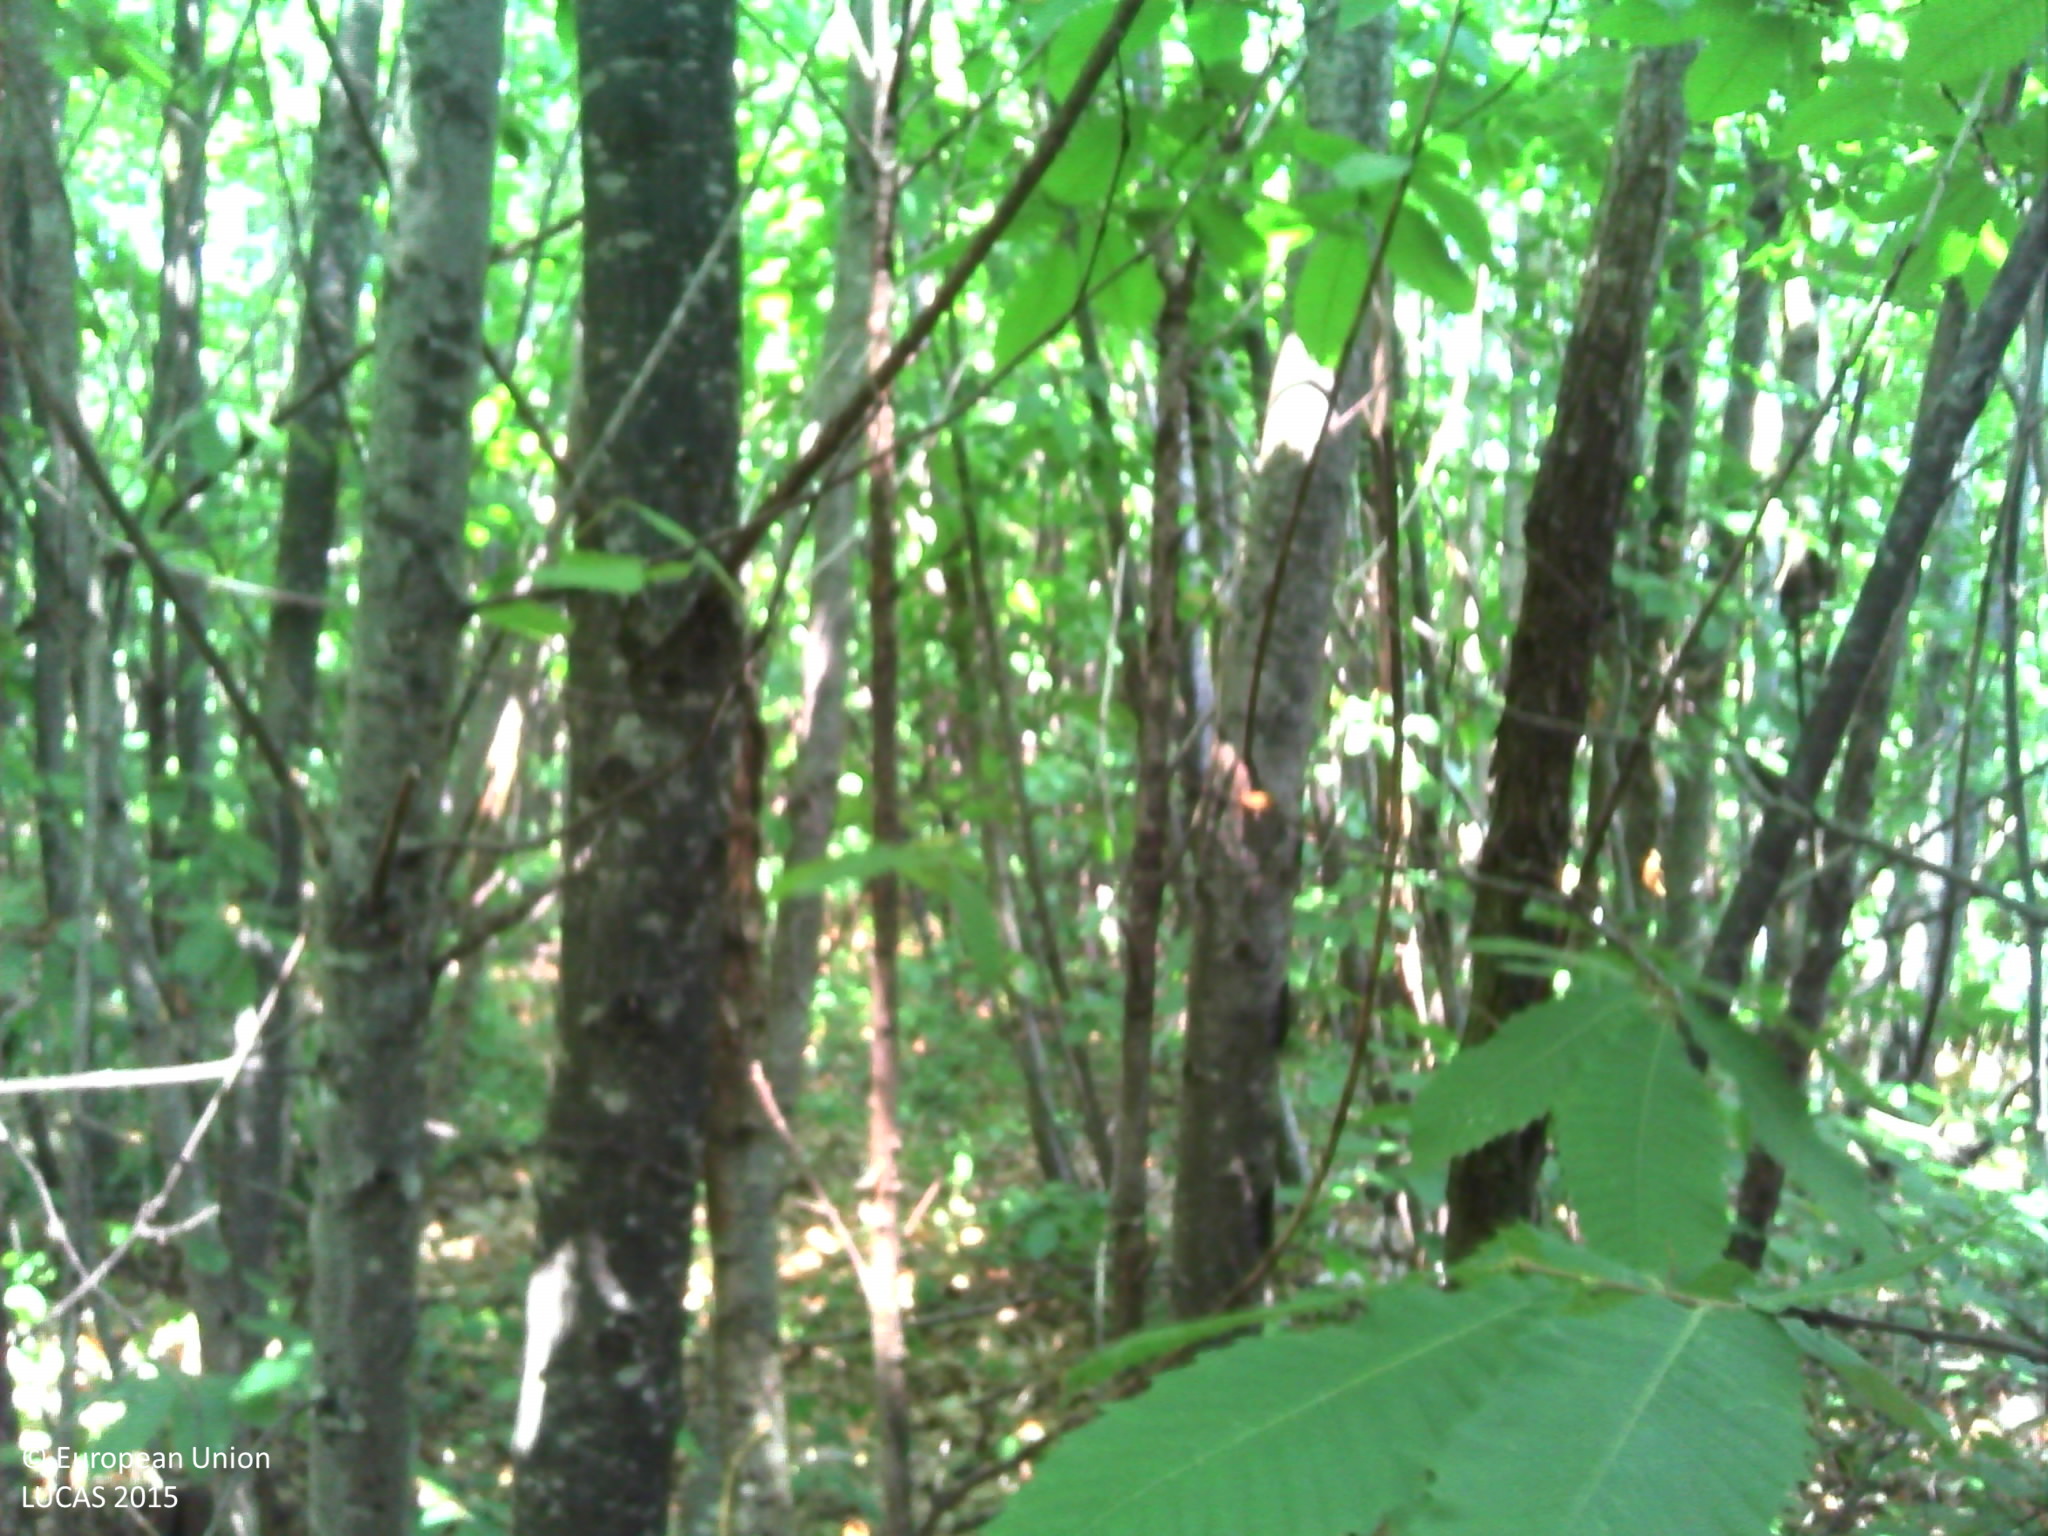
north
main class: Woodland
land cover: Broadleaved woodland
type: thermophilous deciduous forest
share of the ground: > 75 %
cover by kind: broadleaved forest trees 40 %, herbaceous plants 30 %, unconsolidated bare surface 25 %
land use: Forestry
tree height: > 5 m
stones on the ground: 10 - 25 %
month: July
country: FR
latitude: 45.6489
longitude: 1.0466
